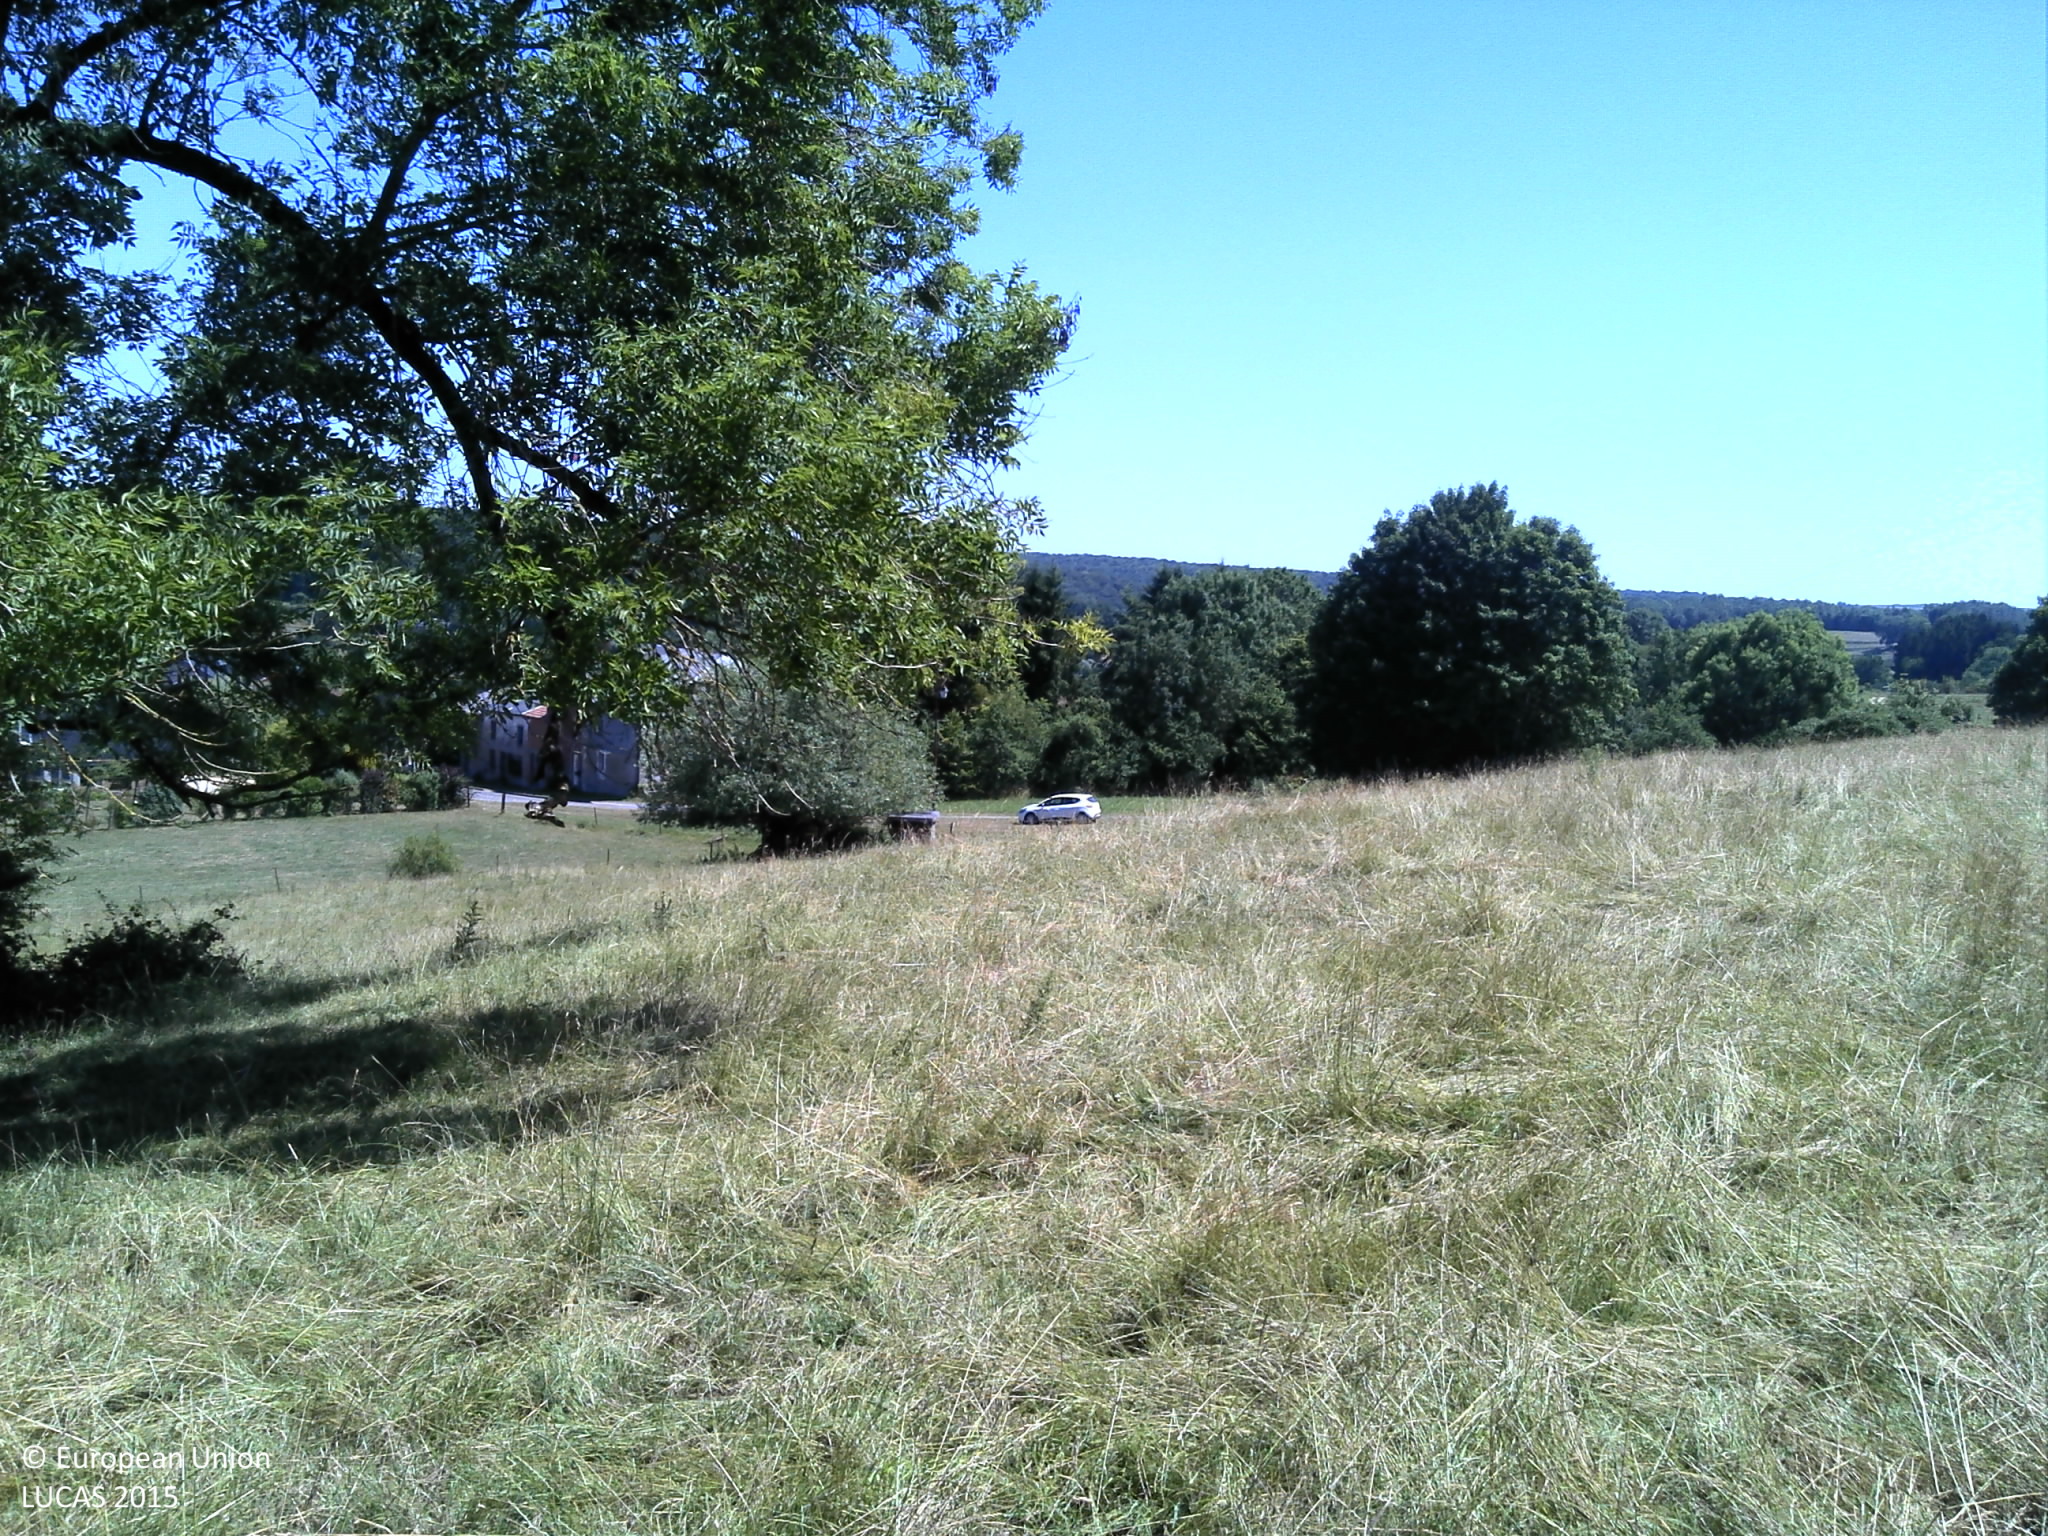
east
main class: Grassland
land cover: Grassland without tree/shrub cover
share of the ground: > 75 %
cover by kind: herbaceous plants 100 %
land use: Agriculture (excluding fallow land and kitchen gardens)
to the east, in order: Grassland without tree/shrub cover; Fences; Grassland without tree/shrub cover; Paved roads, cycling and walking lanes; Grassland without tree/shrub cover; Managed hedges; Grassland with sparse tree/shrub cover; Fences; Broadleaved woodland; Grassland with sparse tree/shrub cover; Fences; Grassland without tree/shrub cover
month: July
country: FR
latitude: 49.5744
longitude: 4.7002
